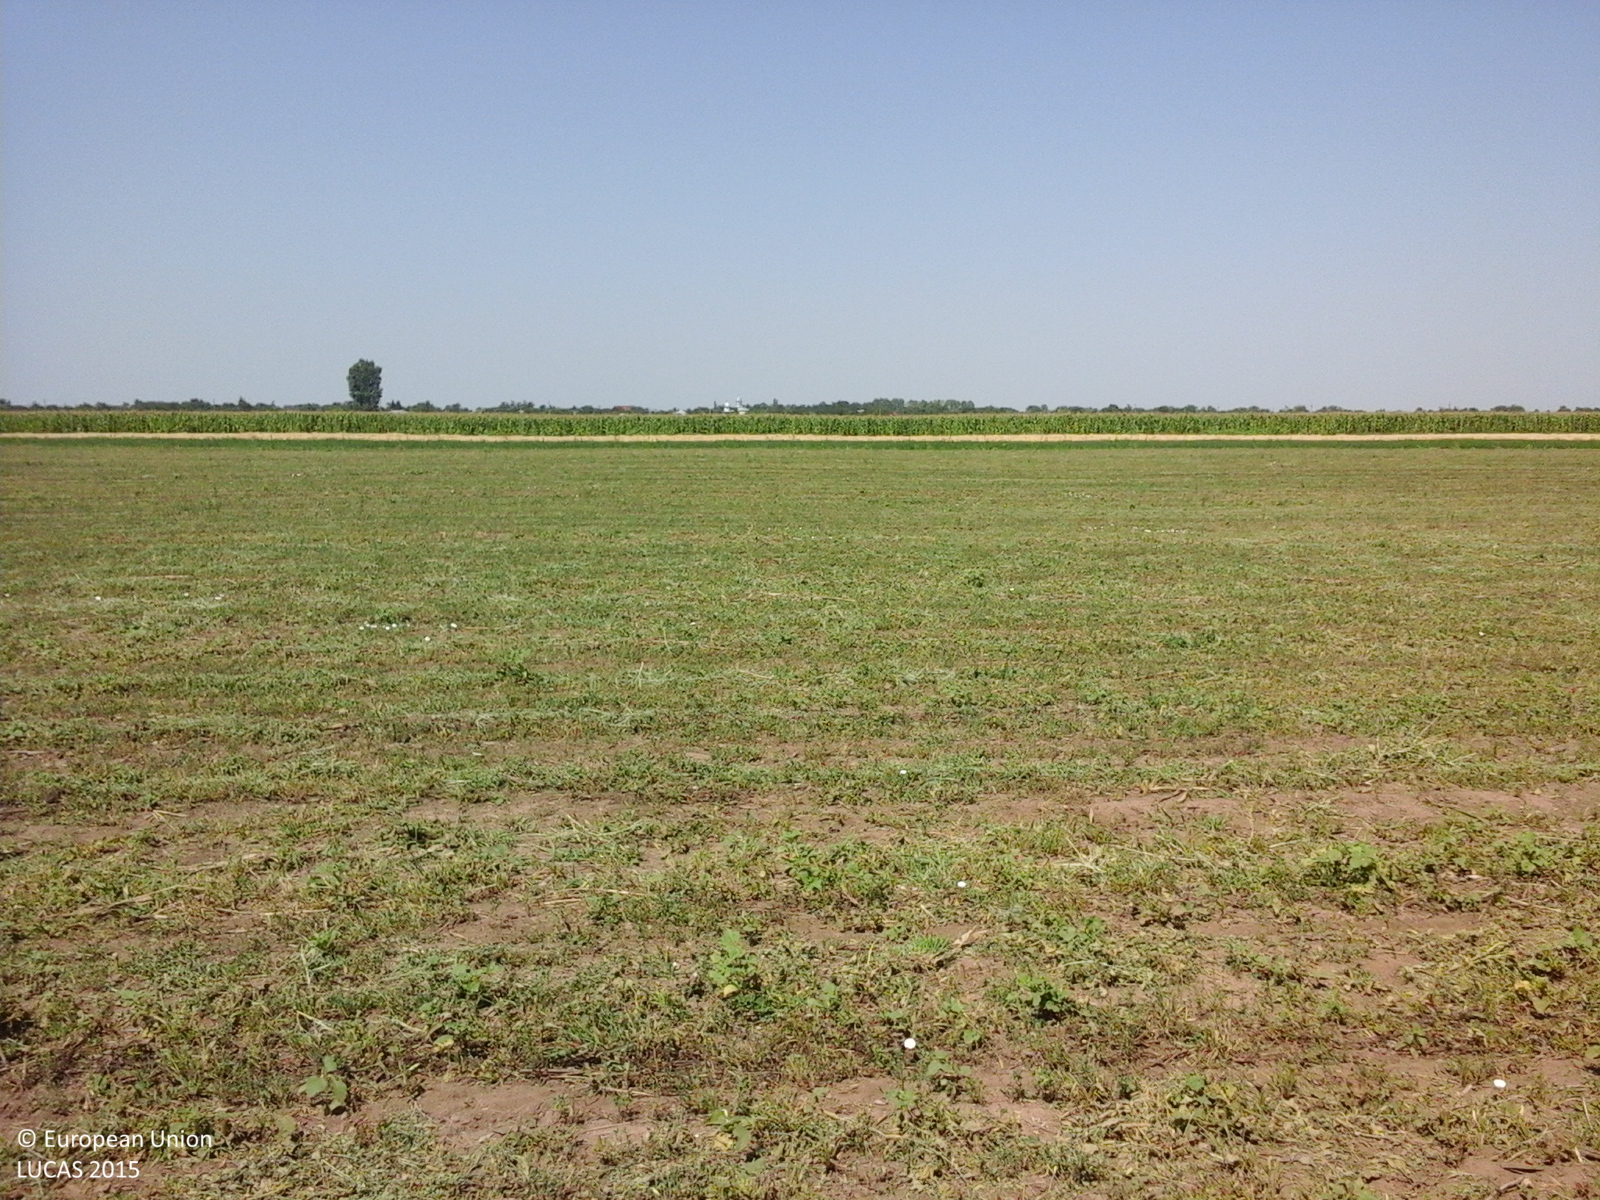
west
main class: Cropland
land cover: Lucerne
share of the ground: 25 - 50 %
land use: Agriculture (excluding fallow land and kitchen gardens)
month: July
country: RO
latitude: 45.0609
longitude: 27.2738
